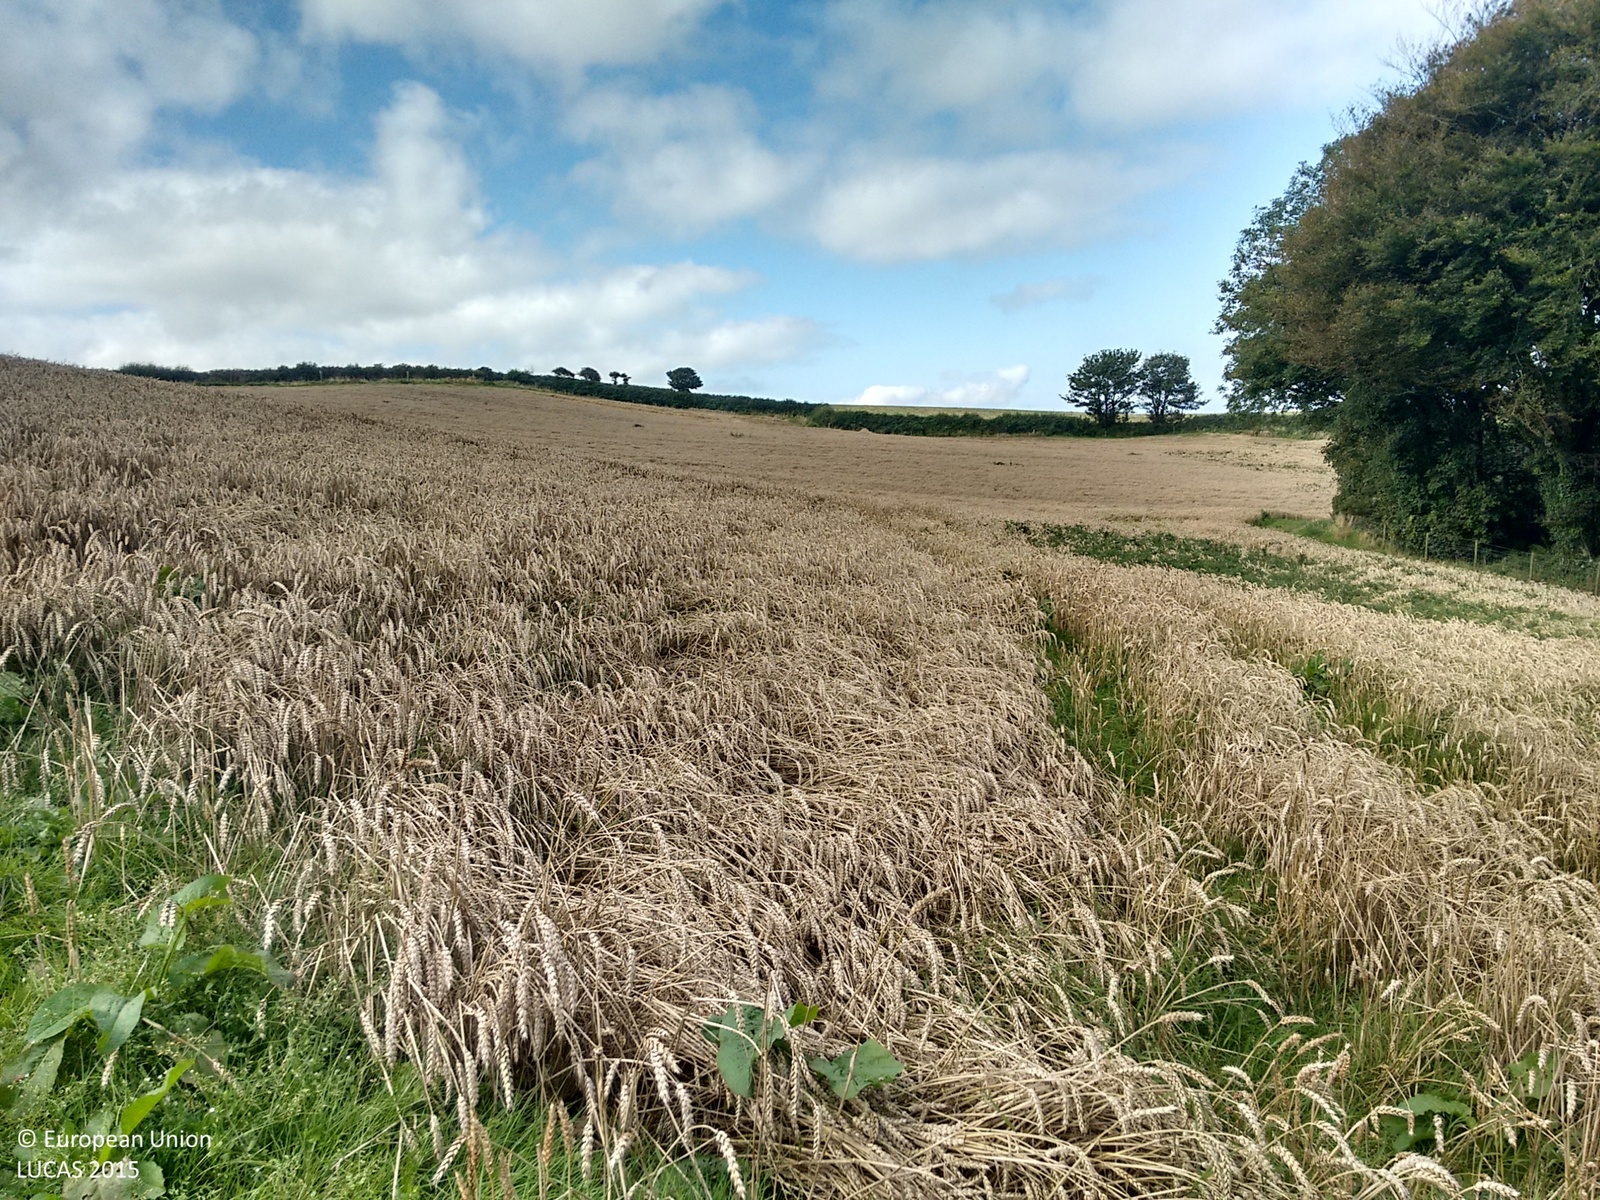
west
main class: Cropland
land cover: Common wheat
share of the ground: > 75 %
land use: Agriculture (excluding fallow land and kitchen gardens)
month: September
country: GB
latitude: 50.9863
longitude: -4.3617
